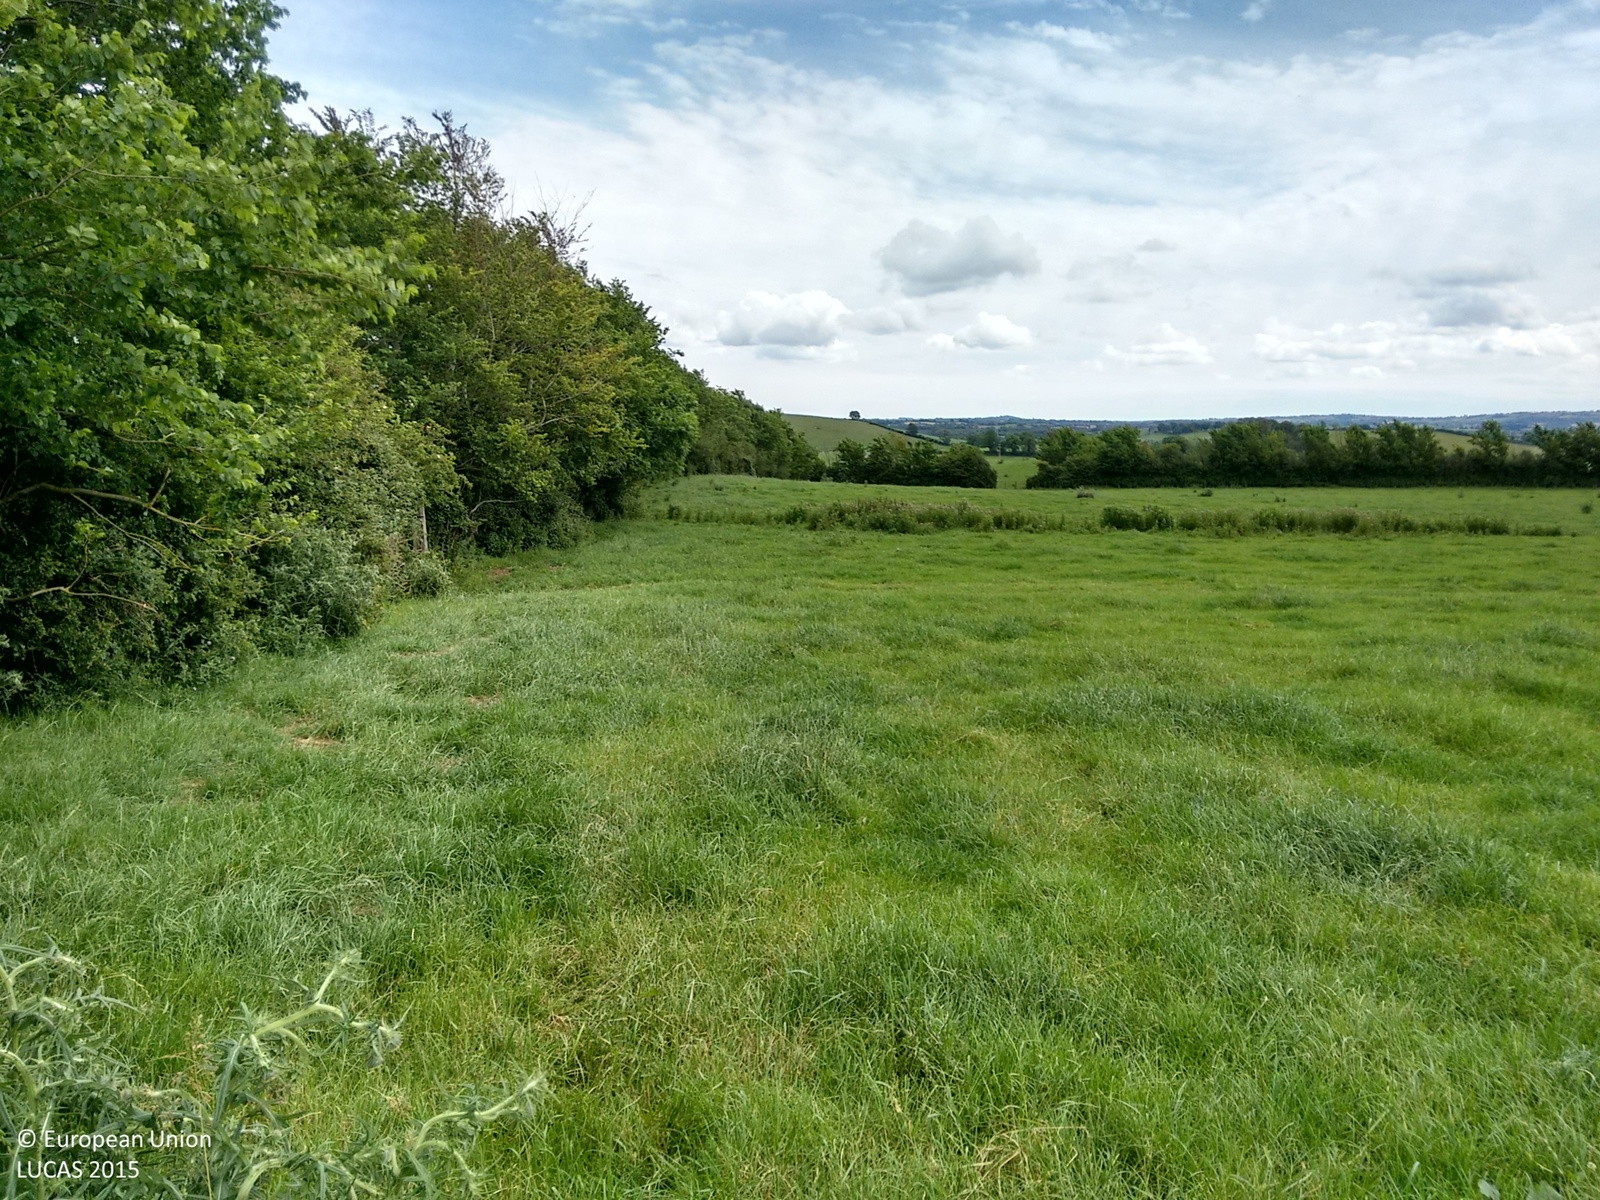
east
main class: Grassland
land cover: Grassland without tree/shrub cover
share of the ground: > 75 %
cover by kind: herbaceous plants 100 %
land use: Agriculture (excluding fallow land and kitchen gardens)
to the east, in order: Grassland without tree/shrub cover; Managed hedges; Fences; Grassland without tree/shrub cover
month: July
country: IE
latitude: 53.8719
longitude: -6.6629
